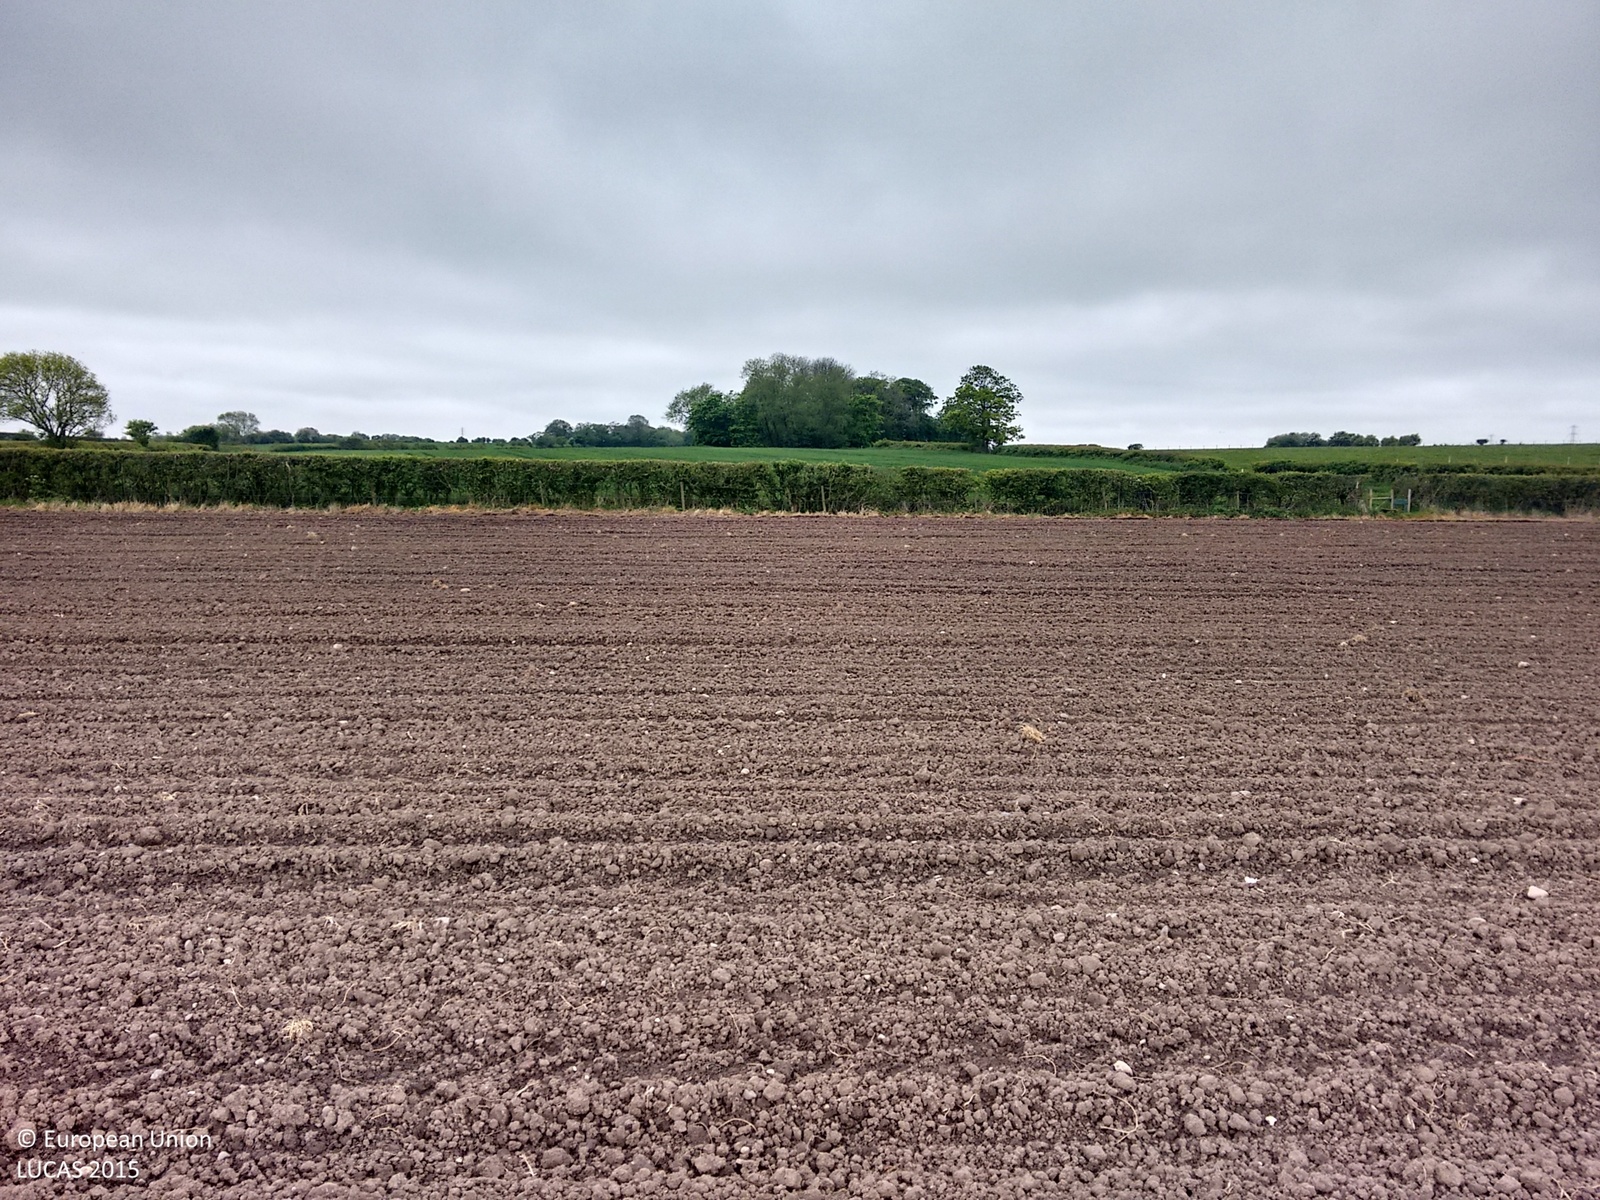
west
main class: Cropland
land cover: Maize
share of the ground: < 10 %
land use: Agriculture (excluding fallow land and kitchen gardens)
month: May
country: GB
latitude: 53.7660
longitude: -2.8910
